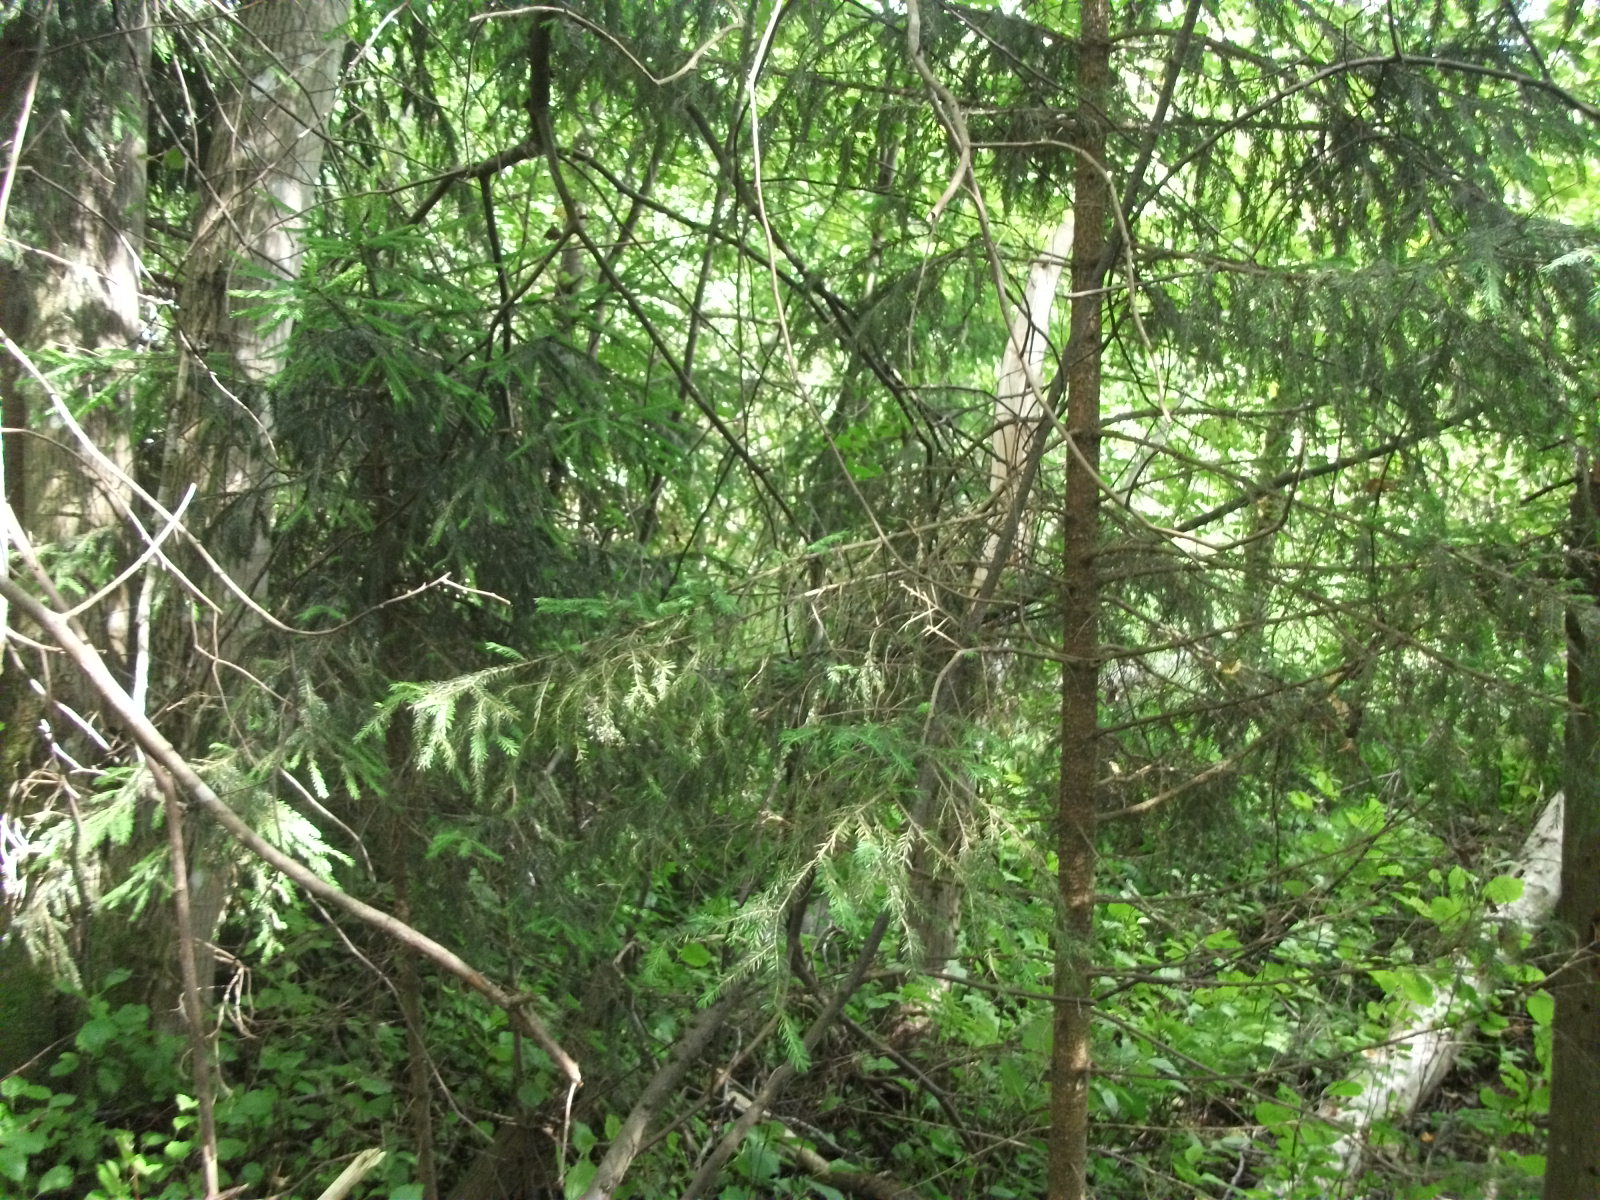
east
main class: Woodland
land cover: Spruce dominated mixed woodland
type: hemiboreal forest and nemoral coniferous forest and mixed broadleaved-coniferous forest
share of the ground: > 75 %
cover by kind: coniferous forest trees 60 %, broadleaved forest trees 30 %, herbaceous plants 10 %
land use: Forestry
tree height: > 5 m
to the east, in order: Spruce dominated mixed woodland; Broadleaved woodland; Other mixed woodland; Broadleaved woodland; Spontaneously vegetated surfaces; Broadleaved woodland
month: July
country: LV
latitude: 57.1301
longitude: 25.9387
